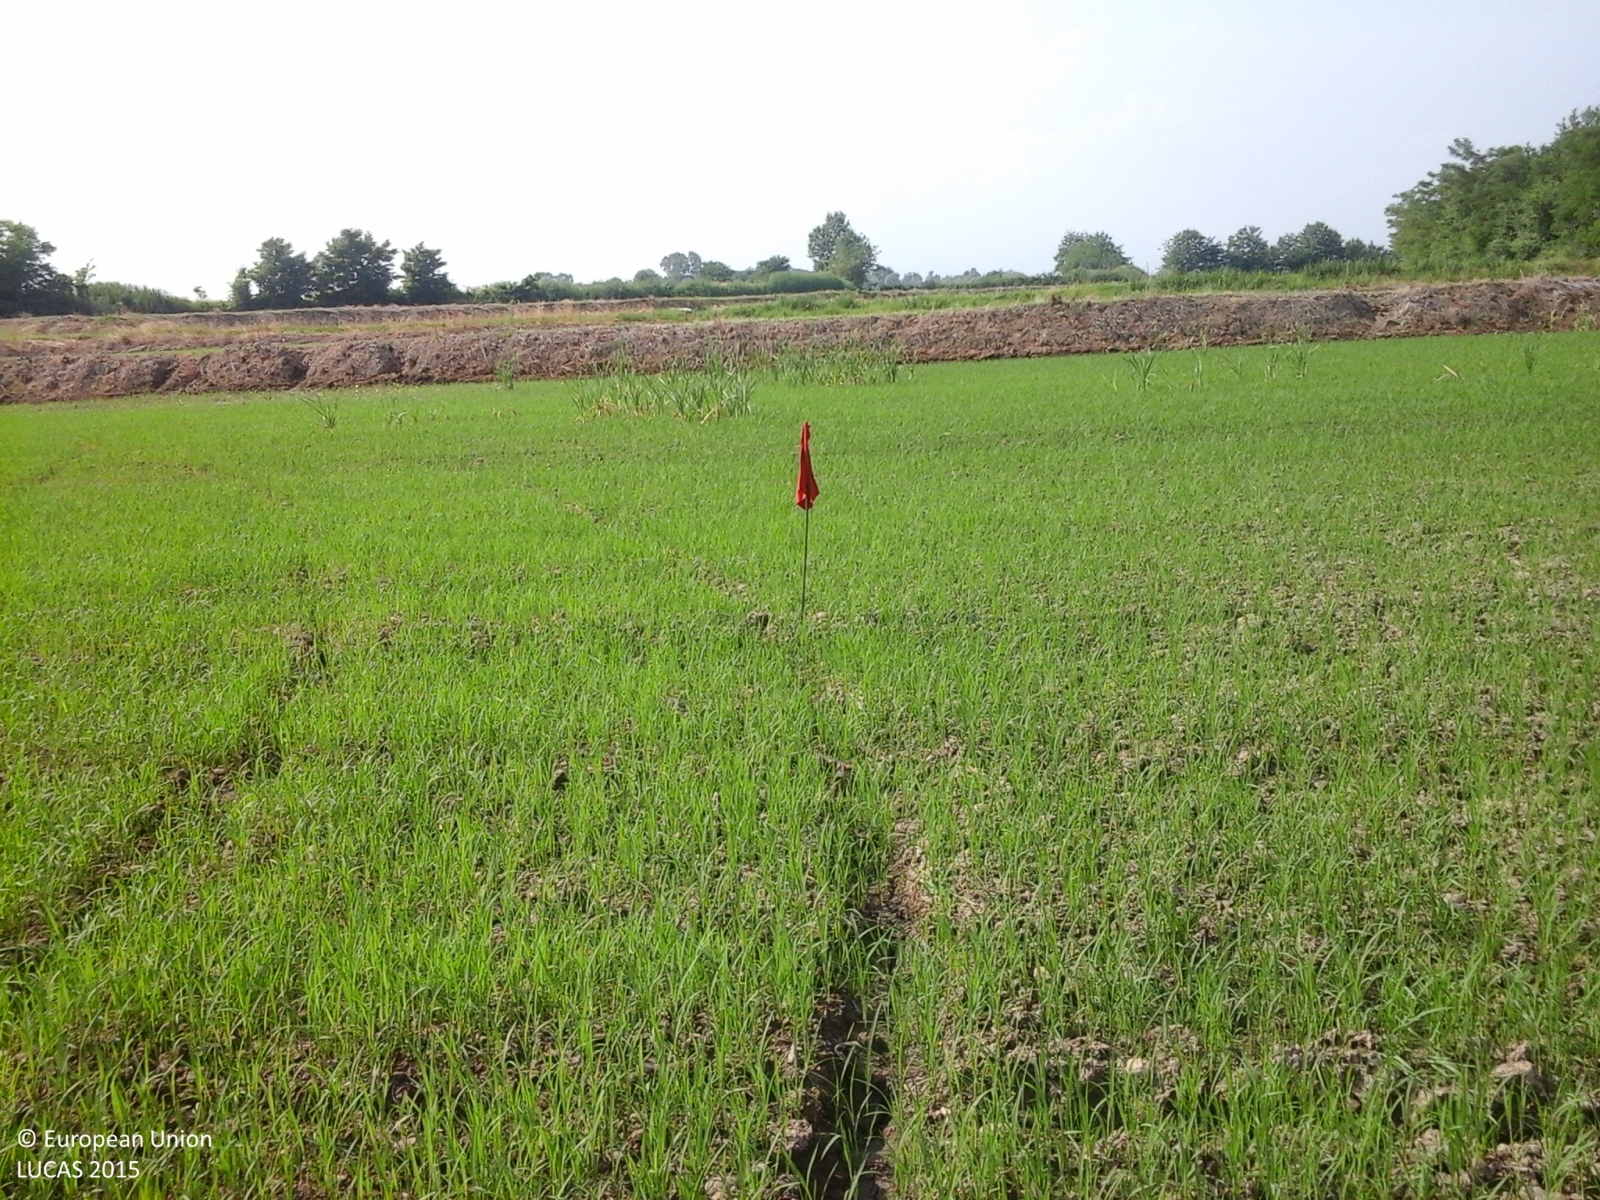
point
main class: Cropland
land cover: Rice
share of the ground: 10 - 25 %
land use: Agriculture (excluding fallow land and kitchen gardens)
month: June
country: IT
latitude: 45.4731
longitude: 8.3271
